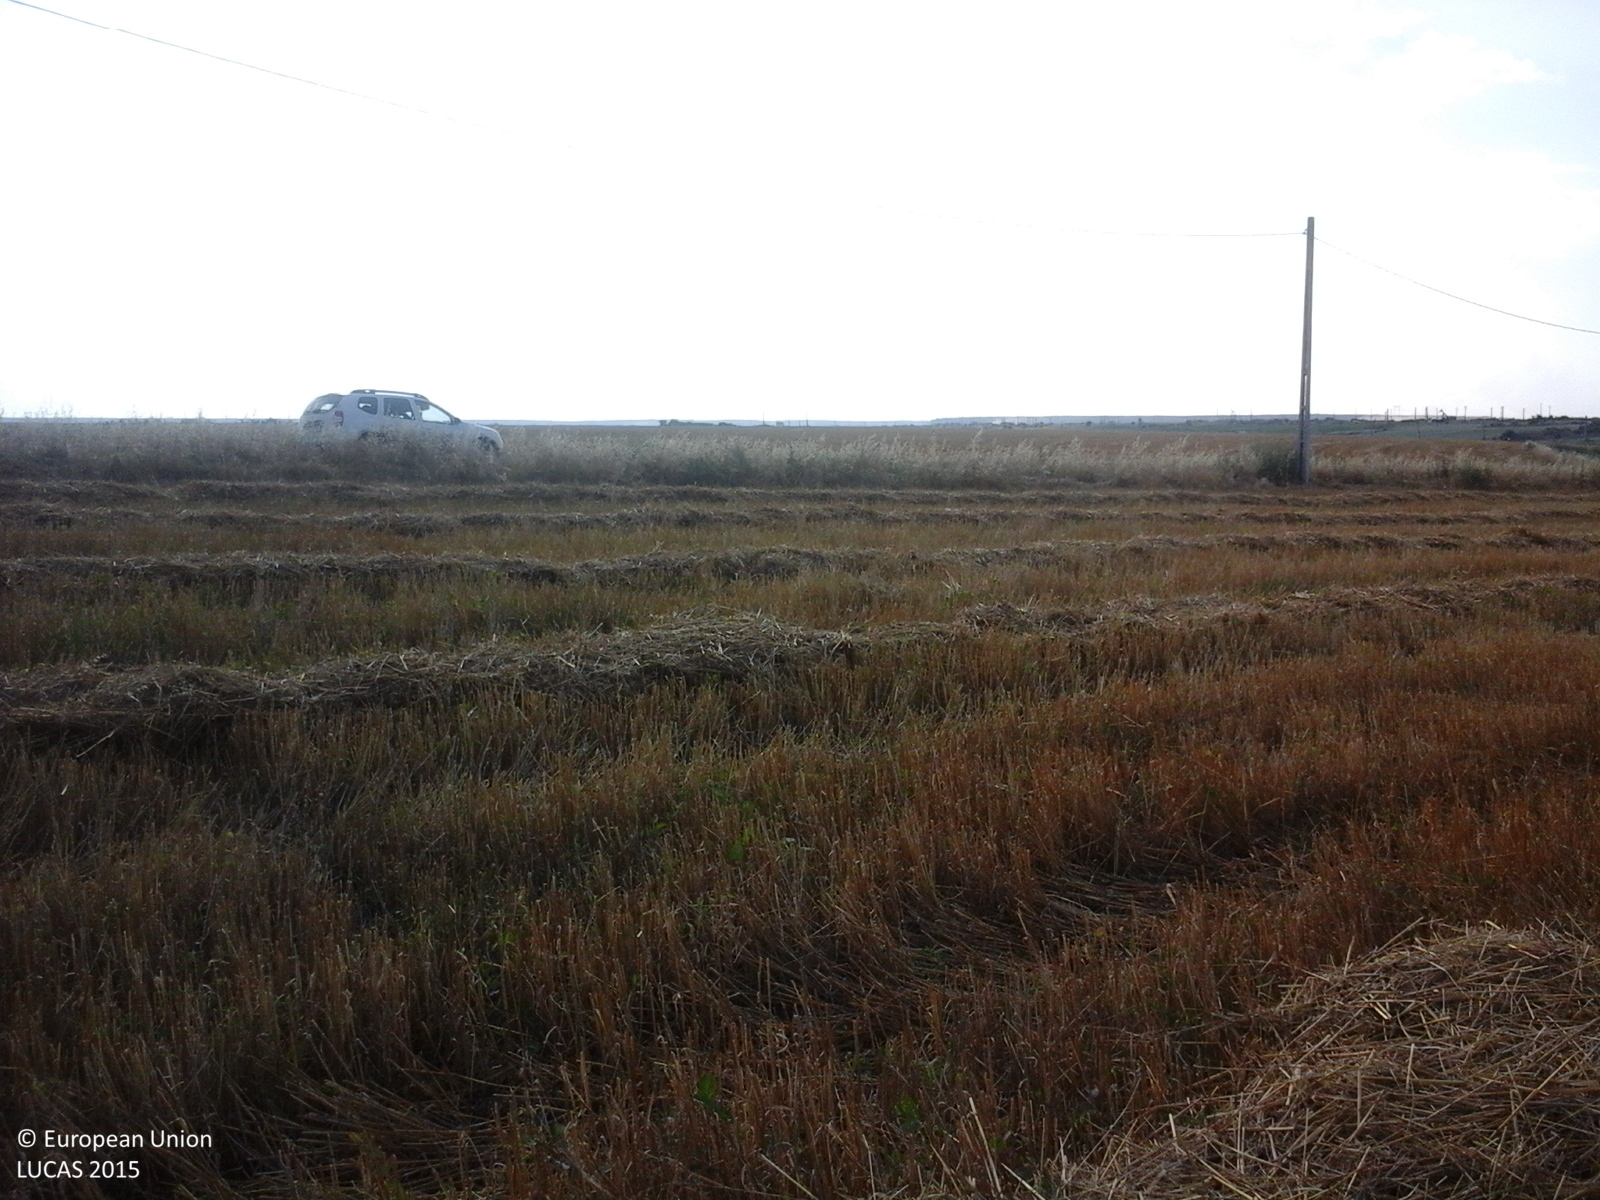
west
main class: Cropland
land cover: Barley
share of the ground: 10 - 25 %
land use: Agriculture (excluding fallow land and kitchen gardens)
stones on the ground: < 10 %
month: July
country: RO
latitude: 44.2483
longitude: 25.8130
